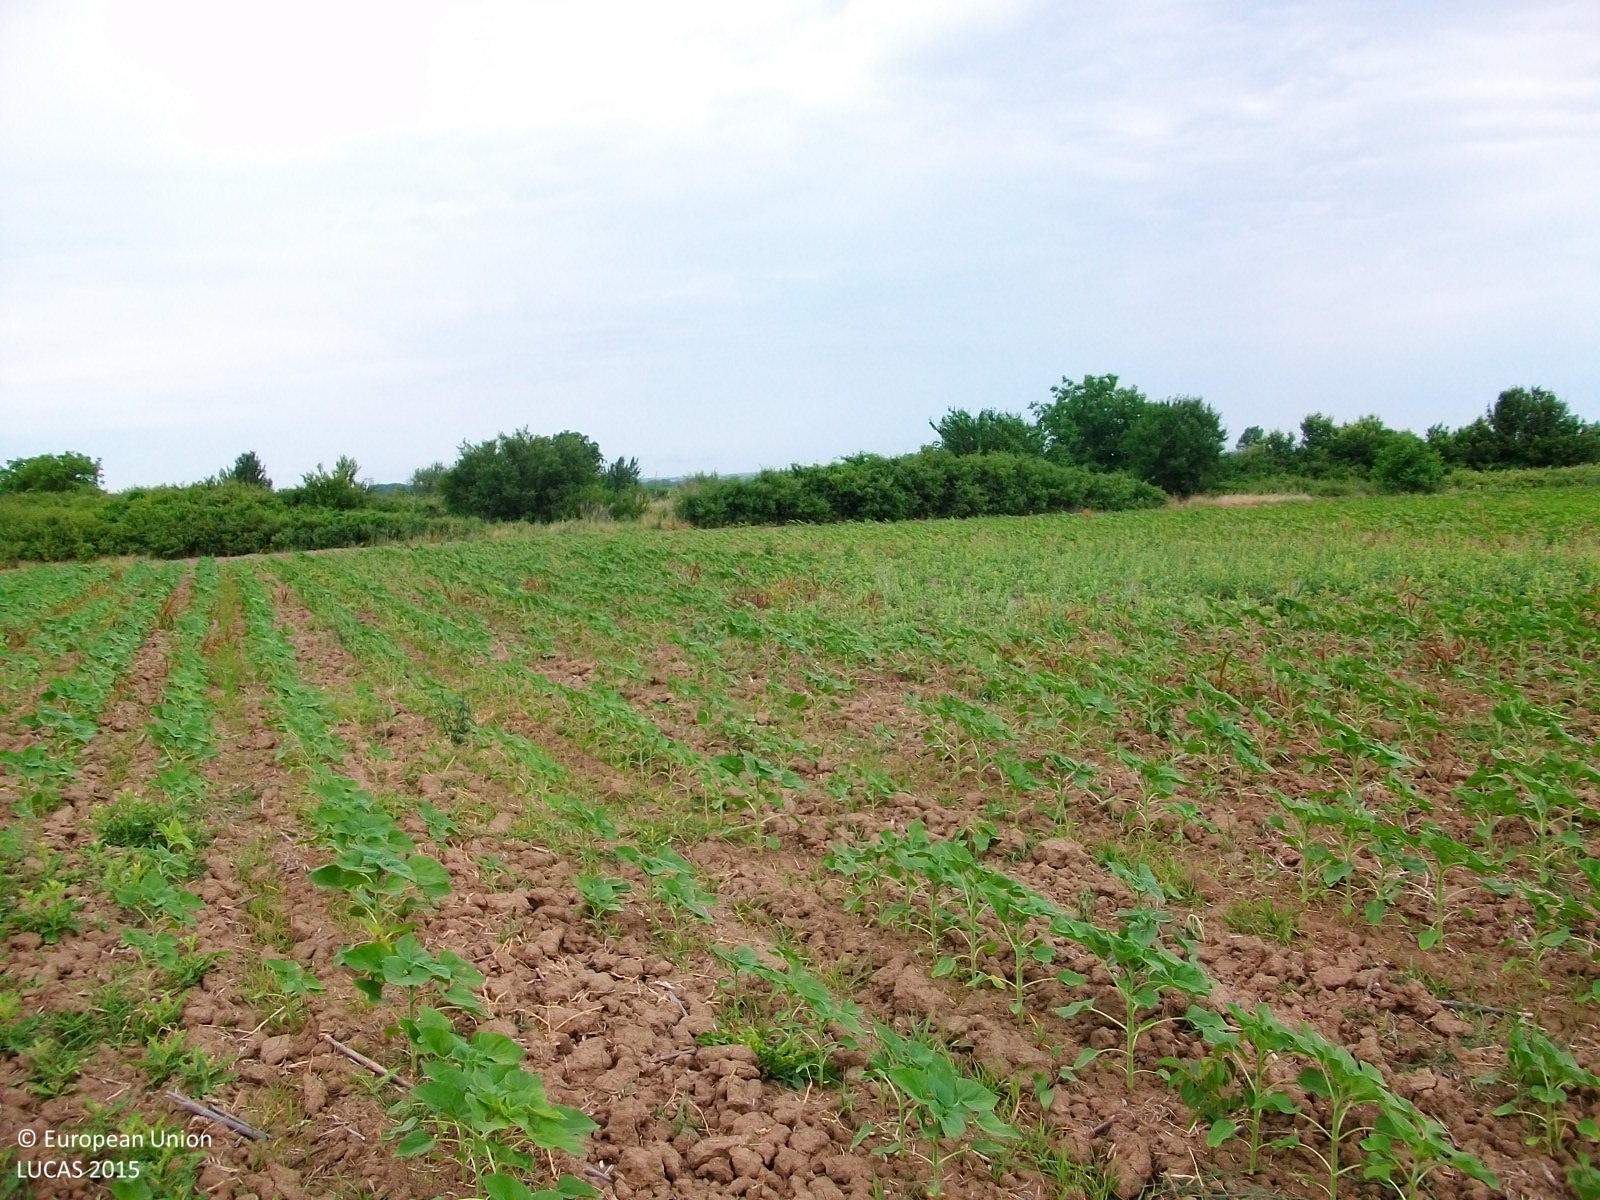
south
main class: Cropland
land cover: Sunflower
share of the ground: 10 - 25 %
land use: Agriculture (excluding fallow land and kitchen gardens)
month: June
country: GR
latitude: 41.6466
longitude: 26.3463
